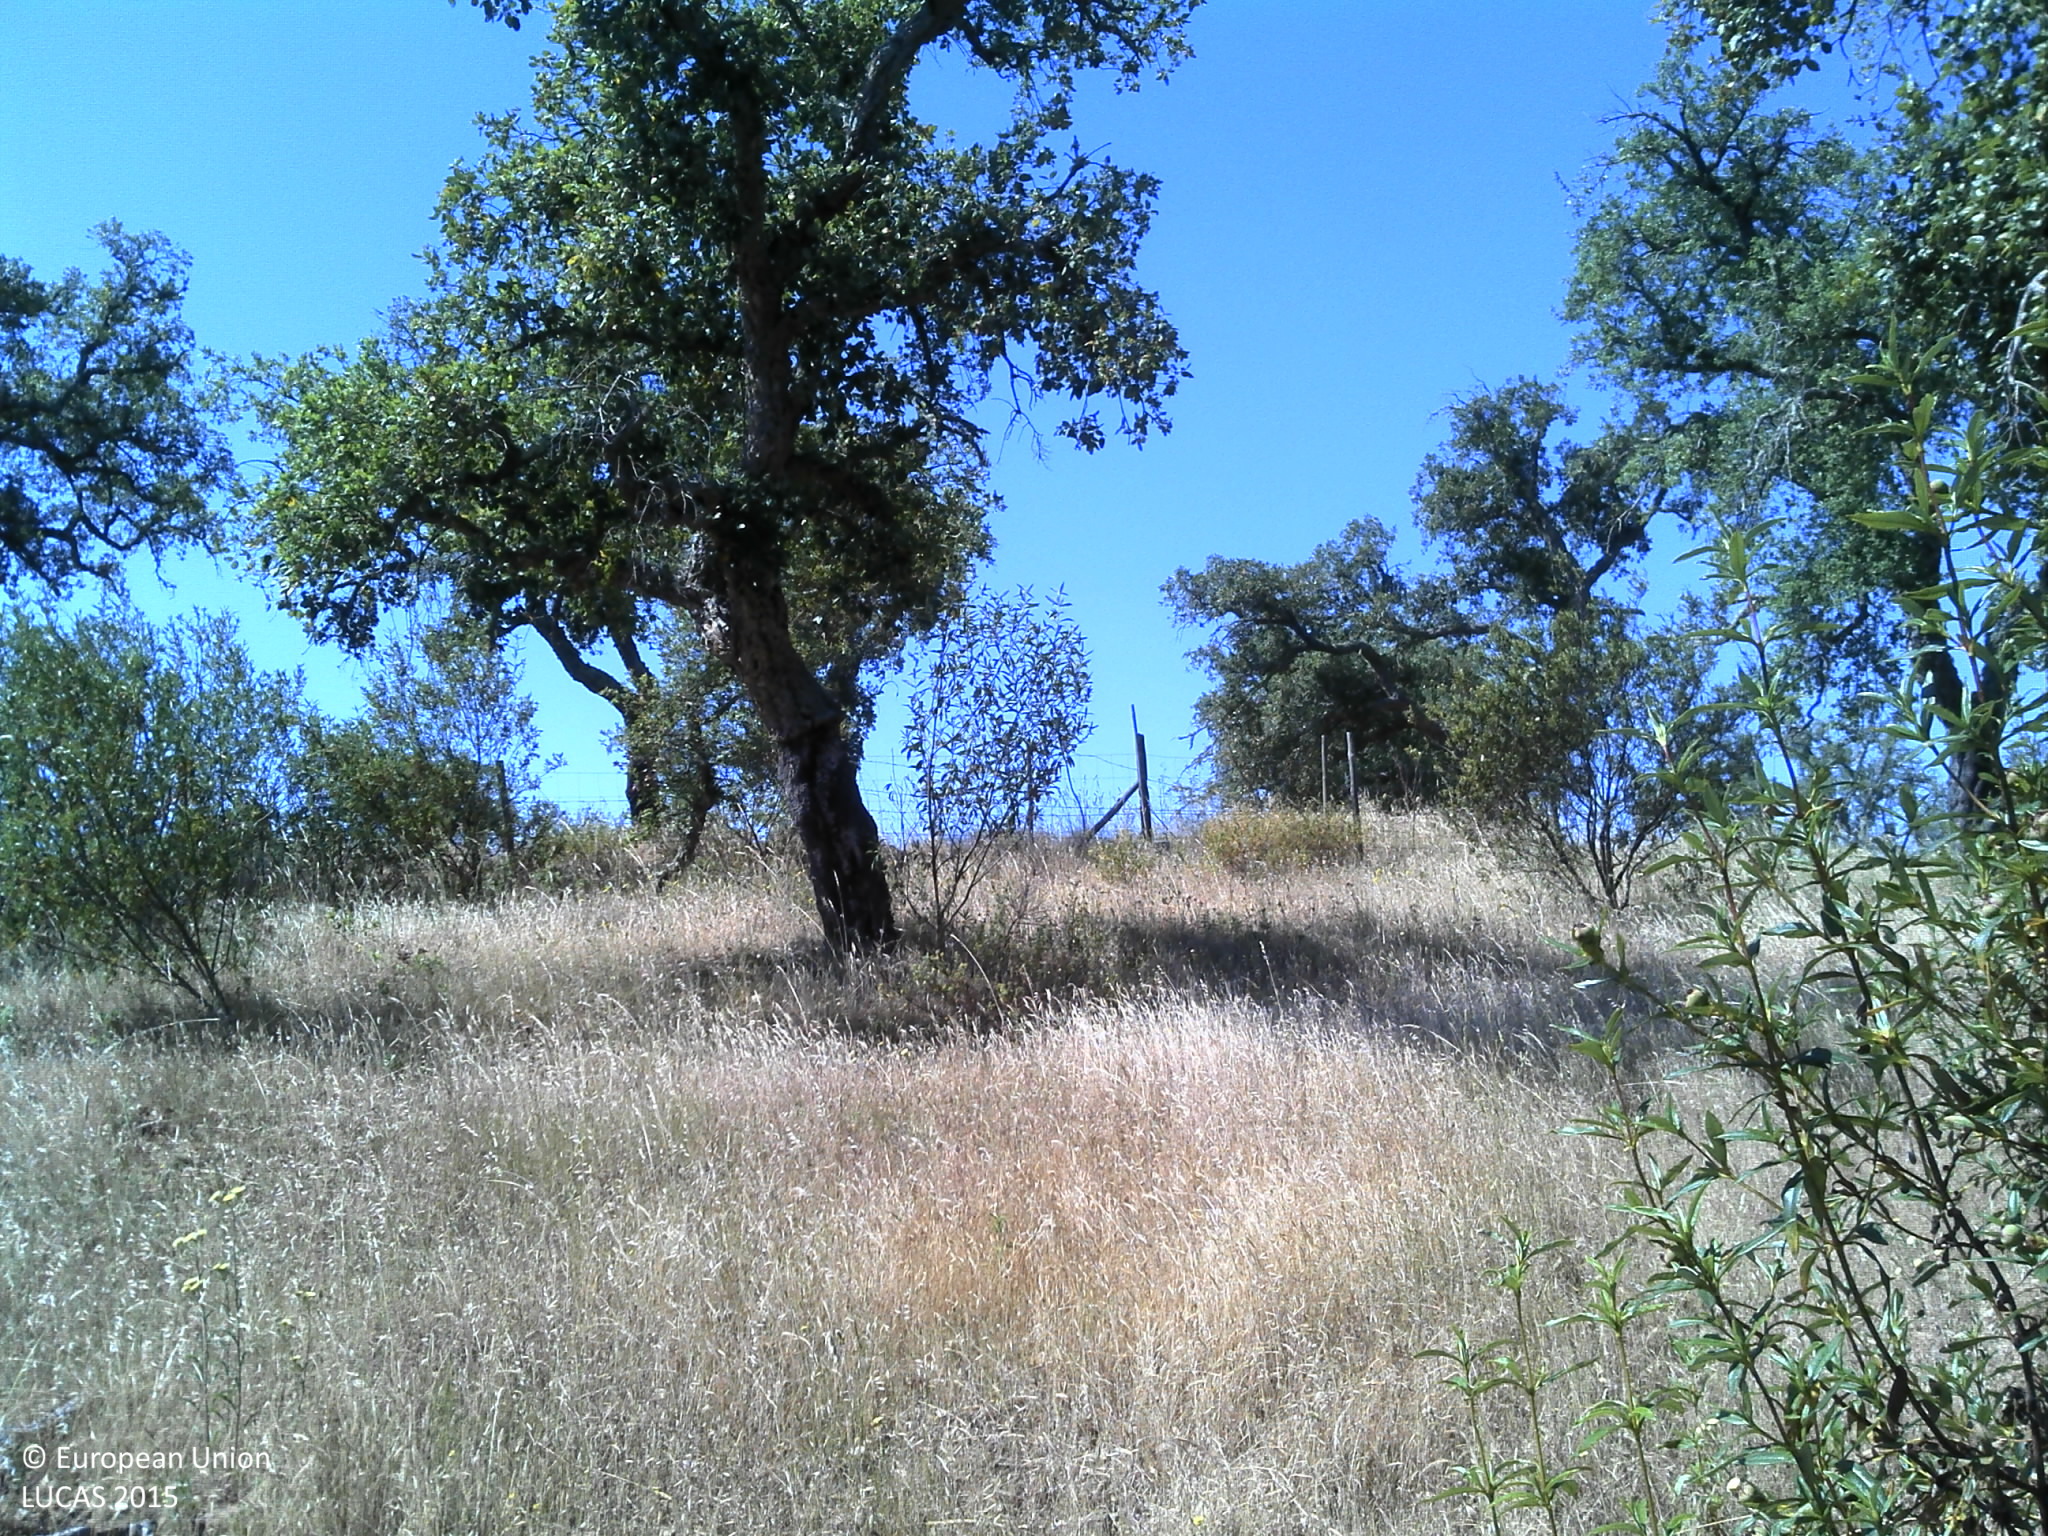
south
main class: Woodland
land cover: Broadleaved woodland
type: broadleaved evergreen forest
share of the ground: 25 - 50 %
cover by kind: broadleaved forest trees 40 %, herbaceous plants 30 %, unconsolidated bare surface 25 %, shrubs 5 %
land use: Forestry
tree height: > 5 m
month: May
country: PT
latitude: 38.1178
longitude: -8.6062
